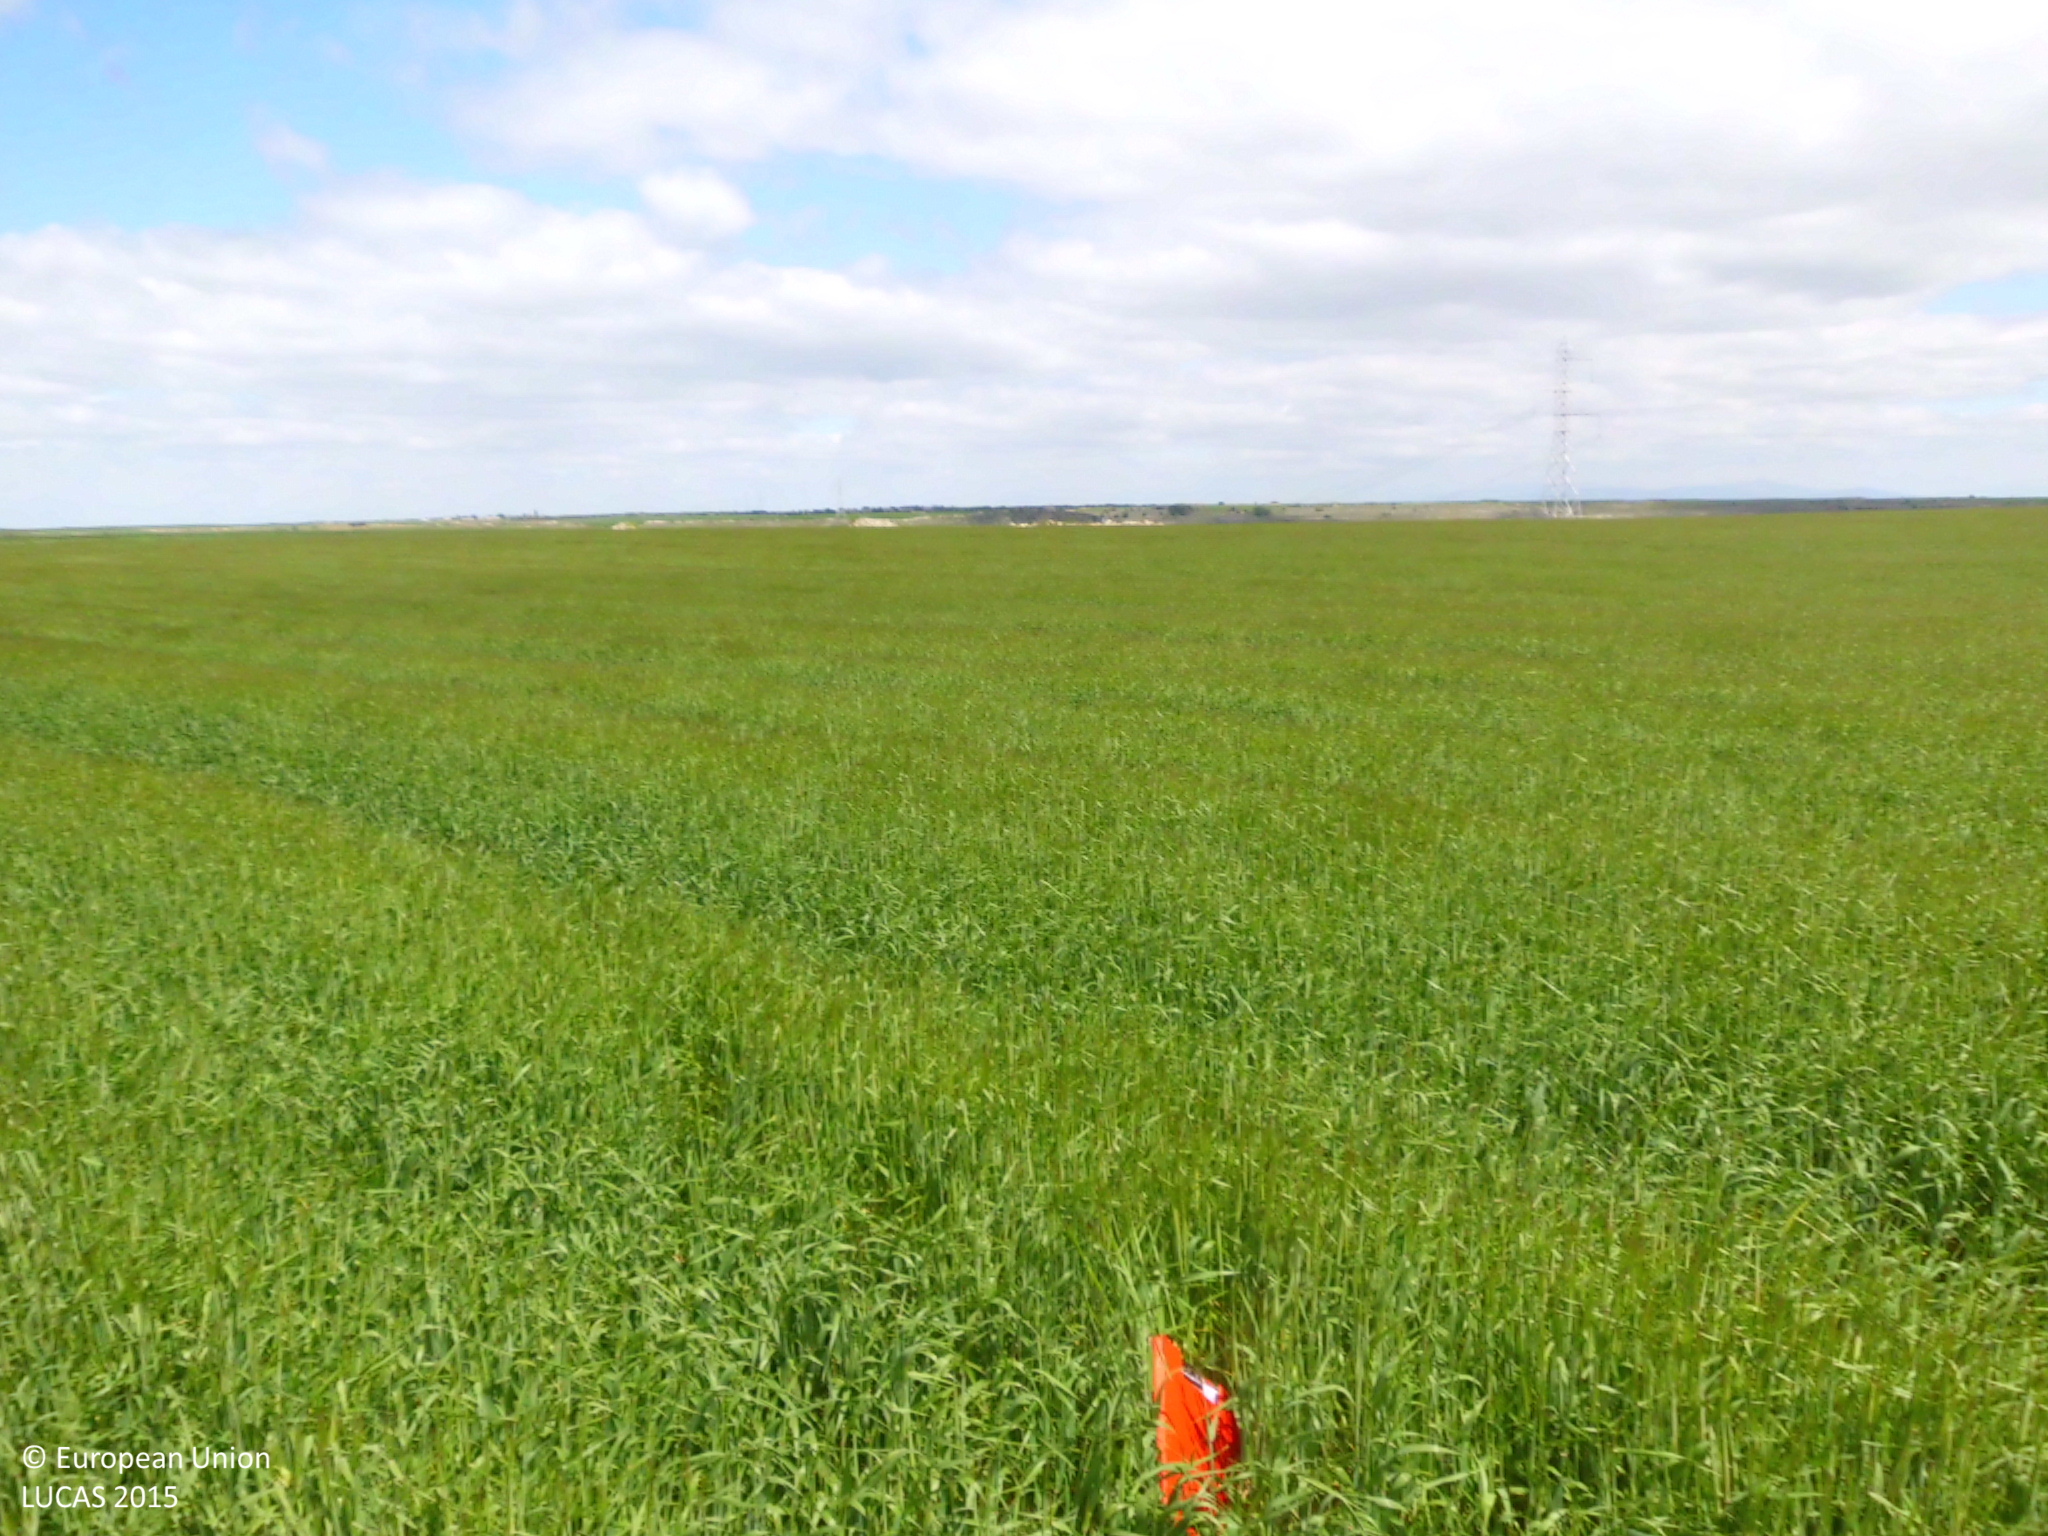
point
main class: Cropland
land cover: Barley
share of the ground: > 75 %
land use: Agriculture (excluding fallow land and kitchen gardens)
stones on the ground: 10 - 25 %
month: May
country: ES
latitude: 42.2983
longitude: -4.0017
